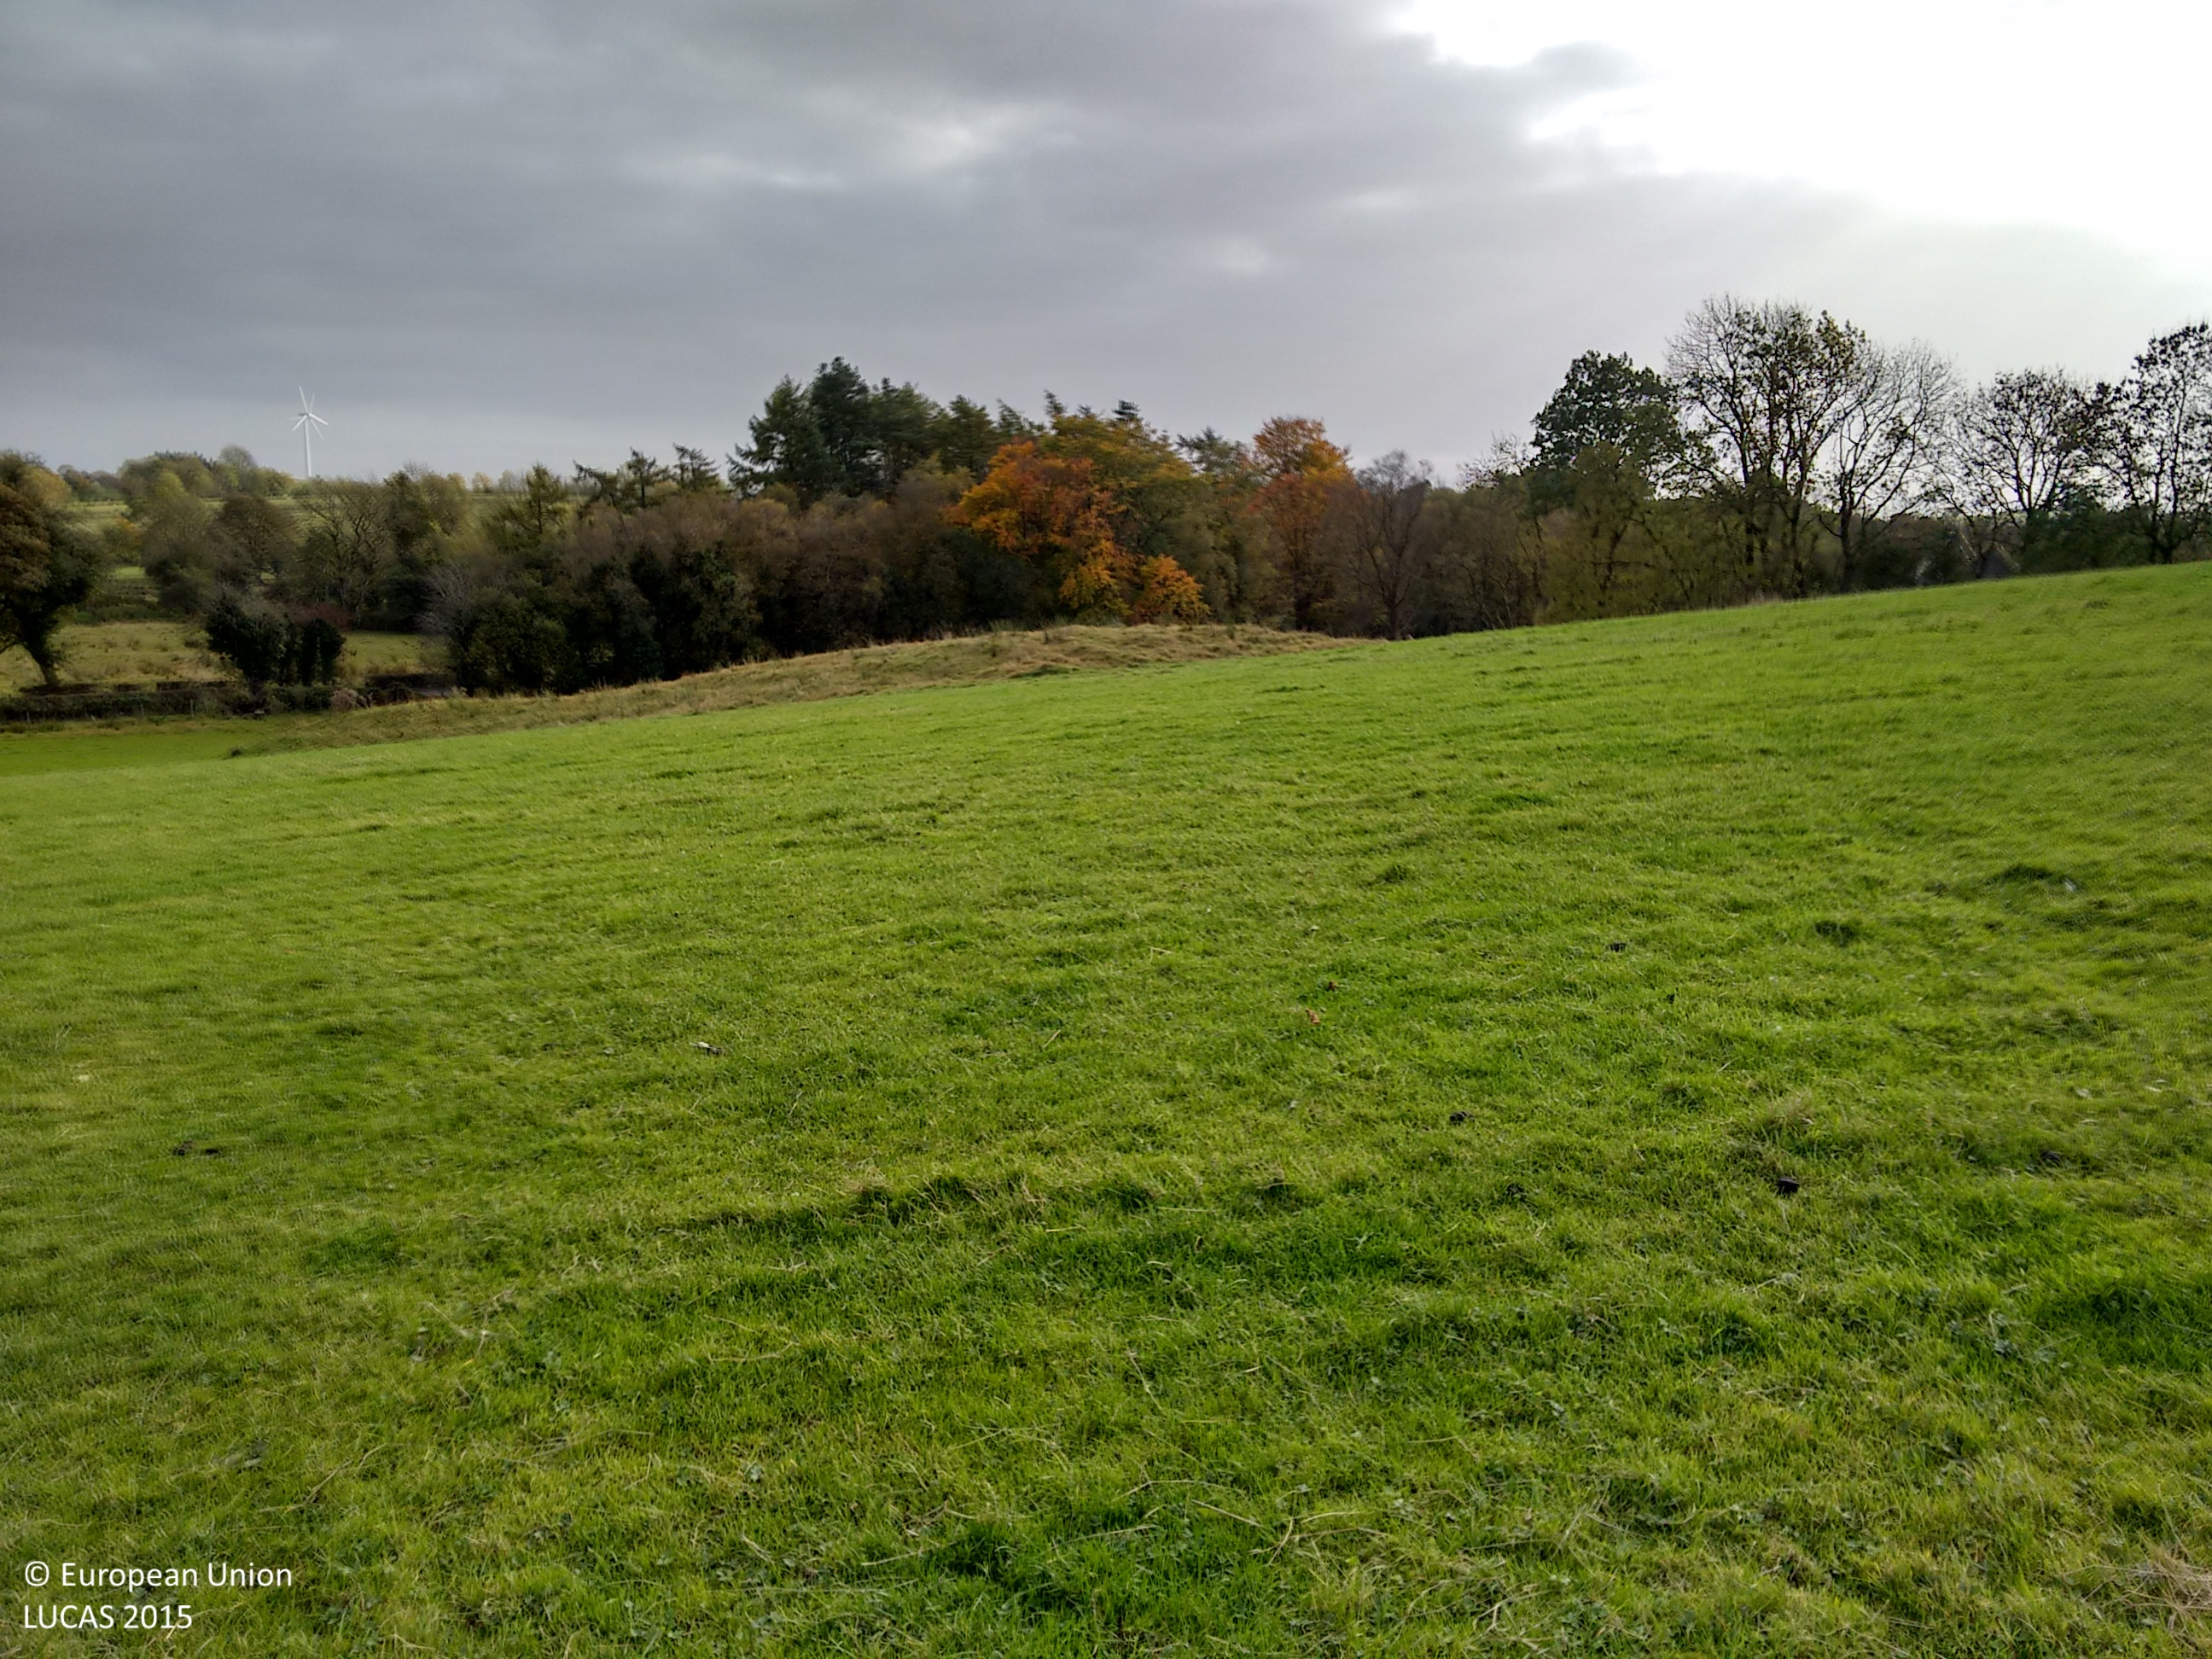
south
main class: Grassland
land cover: Grassland without tree/shrub cover
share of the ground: > 75 %
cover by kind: herbaceous plants 100 %
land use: Agriculture (excluding fallow land and kitchen gardens)
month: October
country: GB
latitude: 54.3919
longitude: -7.4176
